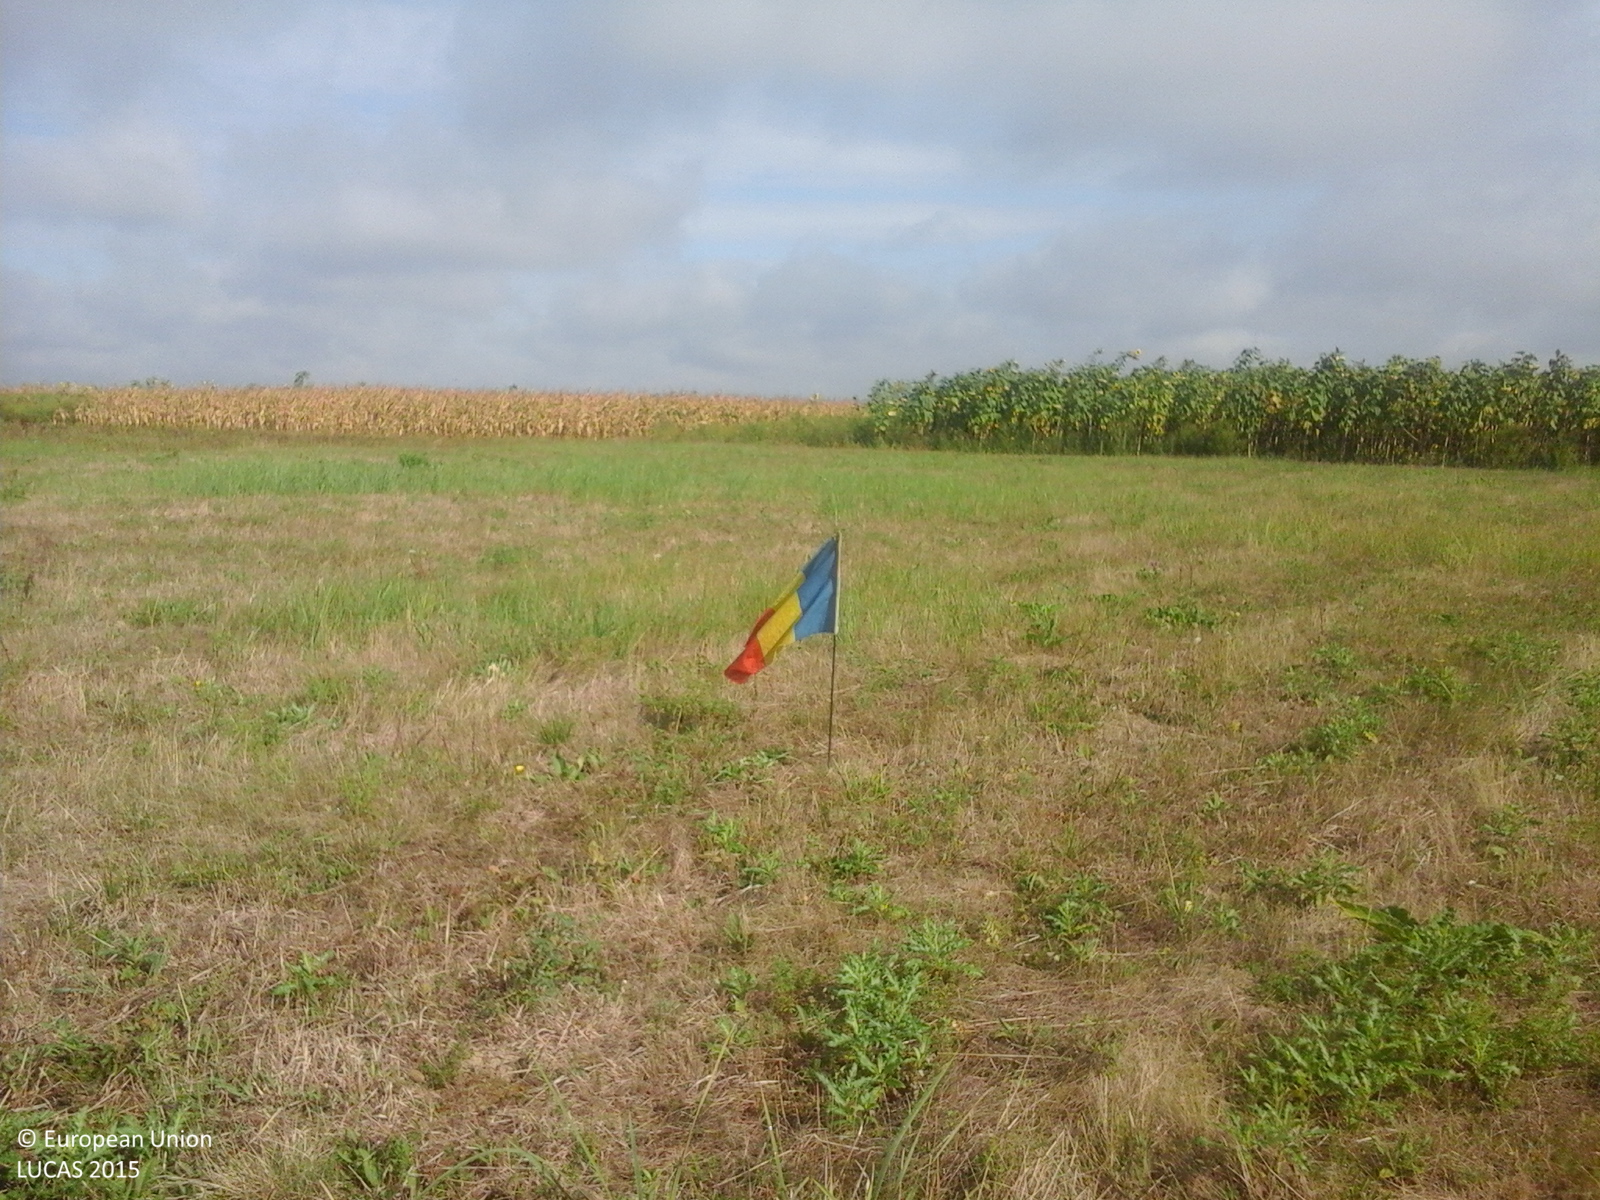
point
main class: Grassland
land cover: Grassland without tree/shrub cover
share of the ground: > 75 %
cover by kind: herbaceous plants 100 %
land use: Agriculture (excluding fallow land and kitchen gardens)
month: September
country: RO
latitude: 47.9643
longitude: 22.9648
